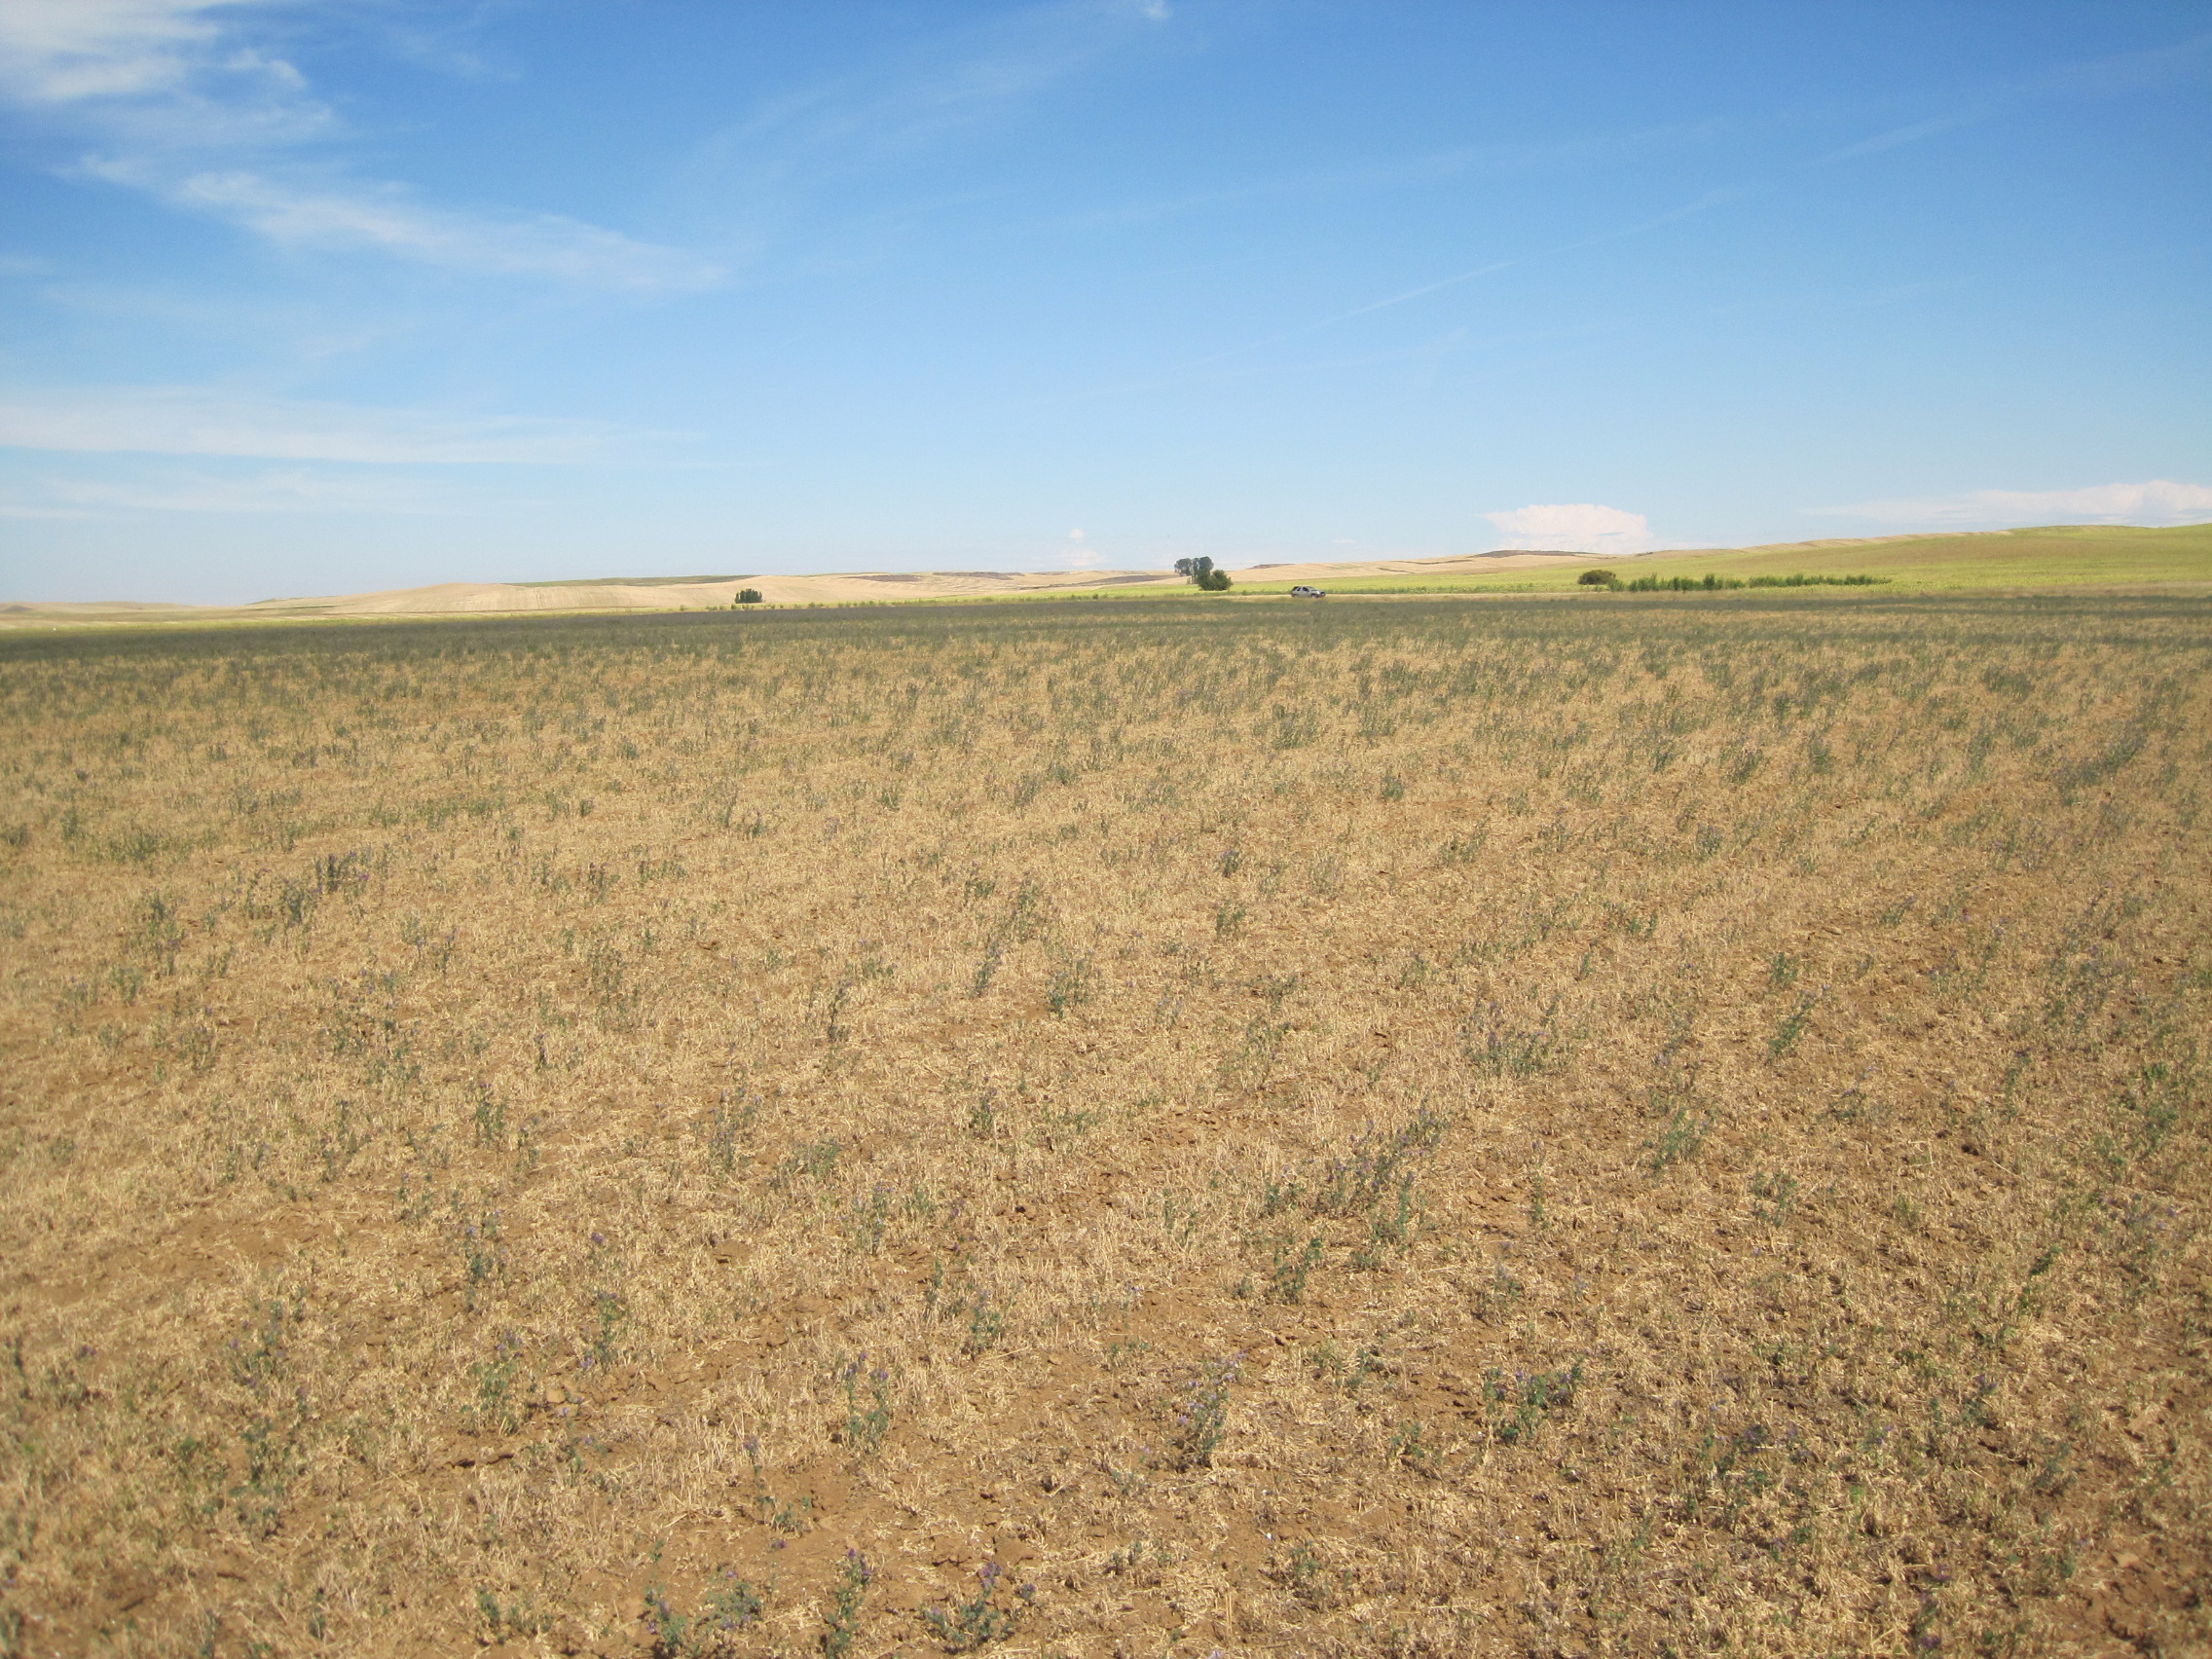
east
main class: Cropland
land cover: Lucerne
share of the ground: 25 - 50 %
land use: Agriculture (excluding fallow land and kitchen gardens)
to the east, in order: Lucerne
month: July
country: ES
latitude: 41.9579
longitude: -5.1989
